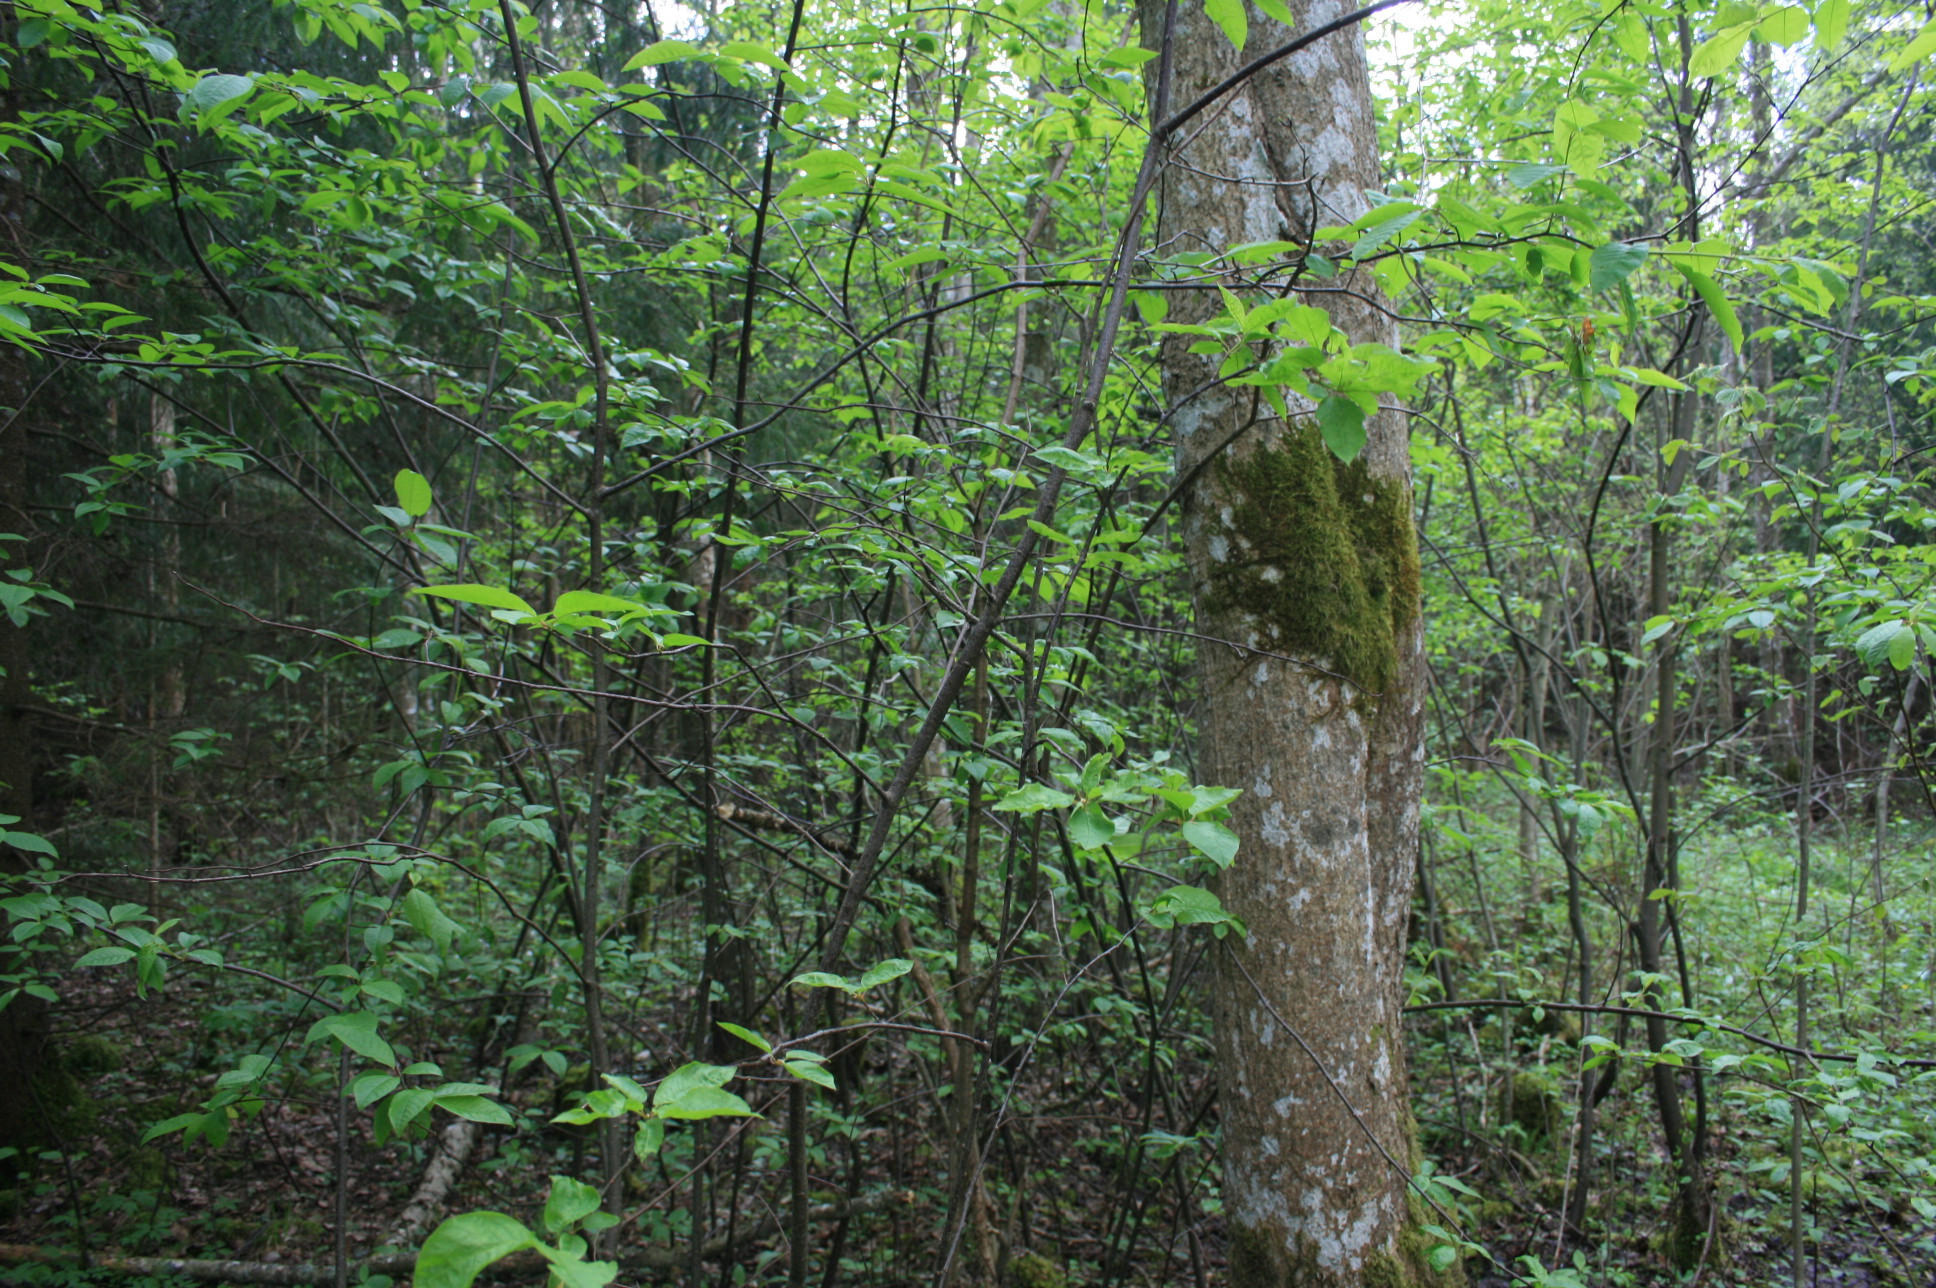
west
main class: Woodland
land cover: Other mixed woodland
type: hemiboreal forest and nemoral coniferous forest and mixed broadleaved-coniferous forest
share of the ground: > 75 %
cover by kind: broadleaved forest trees 60 %, coniferous forest trees 35 %, herbaceous plants 5 %
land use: Forestry
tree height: > 5 m
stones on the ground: < 10 %
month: May
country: LT
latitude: 56.2250
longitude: 21.3801
